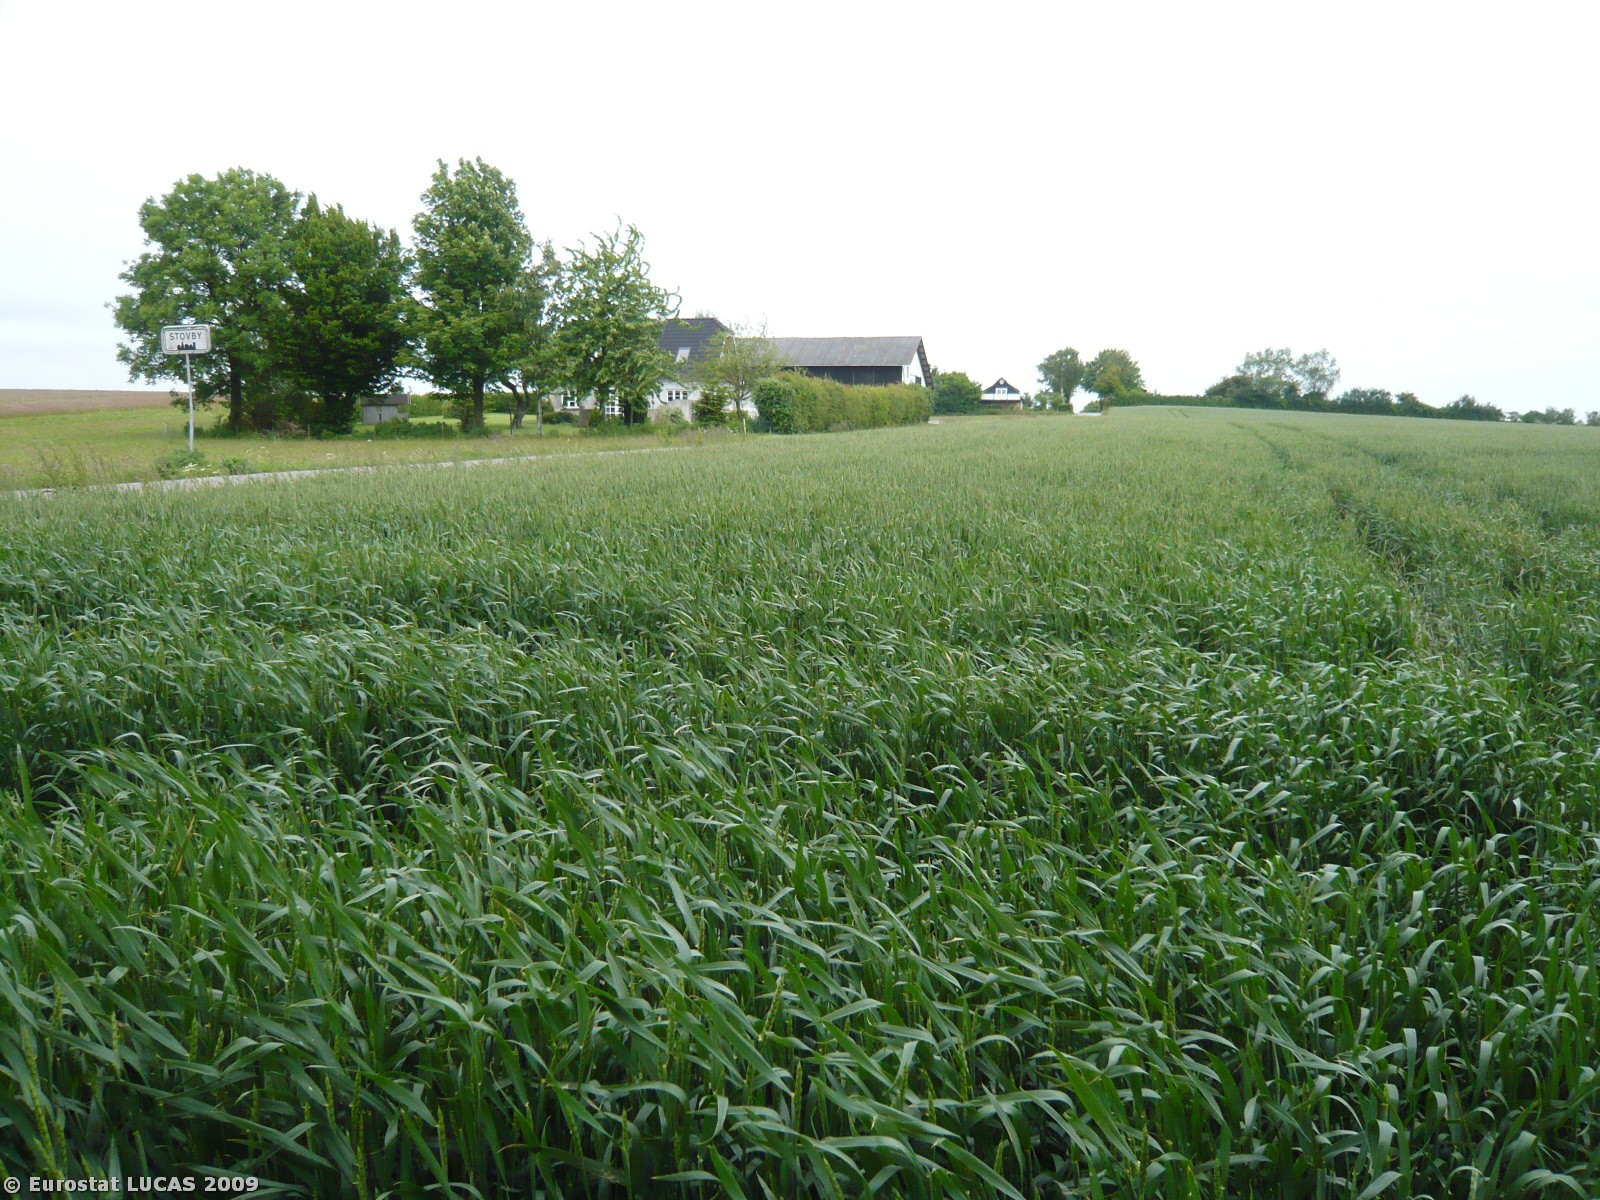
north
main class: Cropland
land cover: Common wheat
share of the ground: > 75 %
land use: Agriculture (excluding fallow land and kitchen gardens)
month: June
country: DK
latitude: 54.7168
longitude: 11.9393
